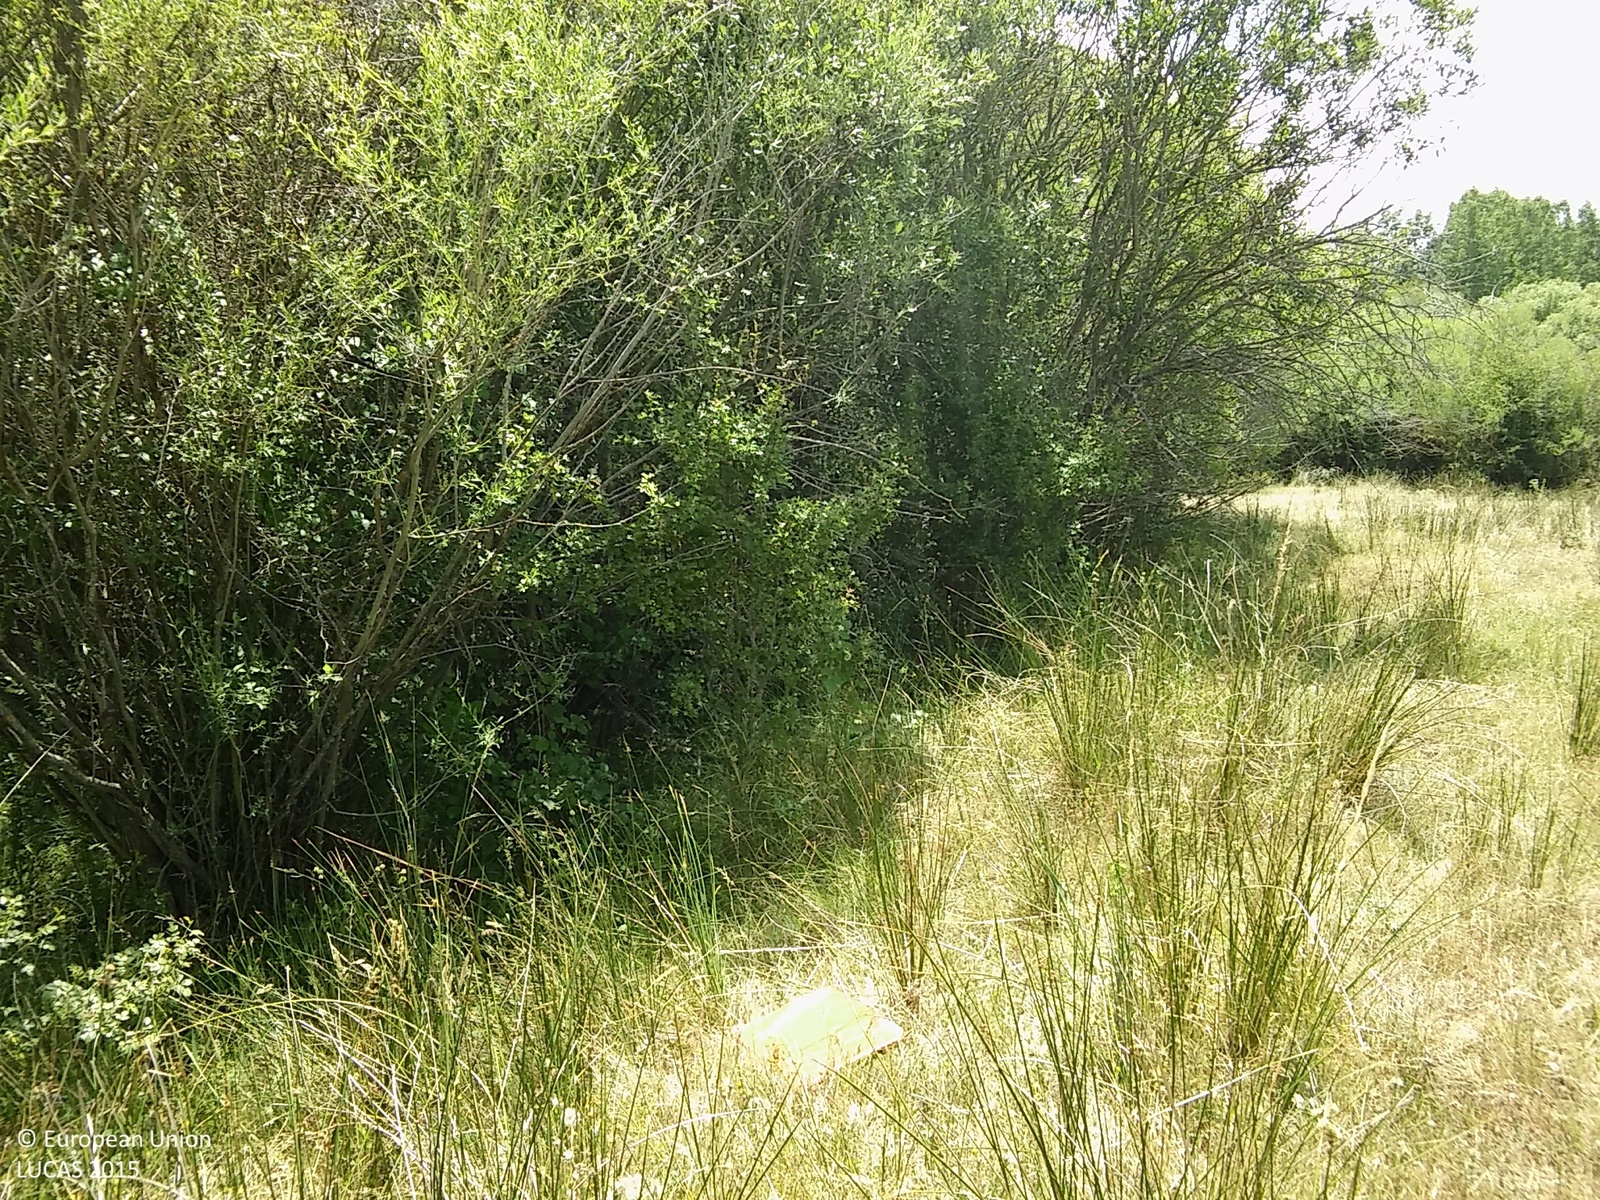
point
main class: Woodland
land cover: Broadleaved woodland
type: floodplain forest
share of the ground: 50 - 75 %
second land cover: Grassland without tree/shrub cover
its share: 25 - 50 %
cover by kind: broadleaved forest trees 60 %, herbaceous plants 35 %, shrubs 5 %
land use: Forestry
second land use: Agriculture (excluding fallow land and kitchen gardens)
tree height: > 5 m
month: June
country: ES
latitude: 41.3008
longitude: -3.6751
